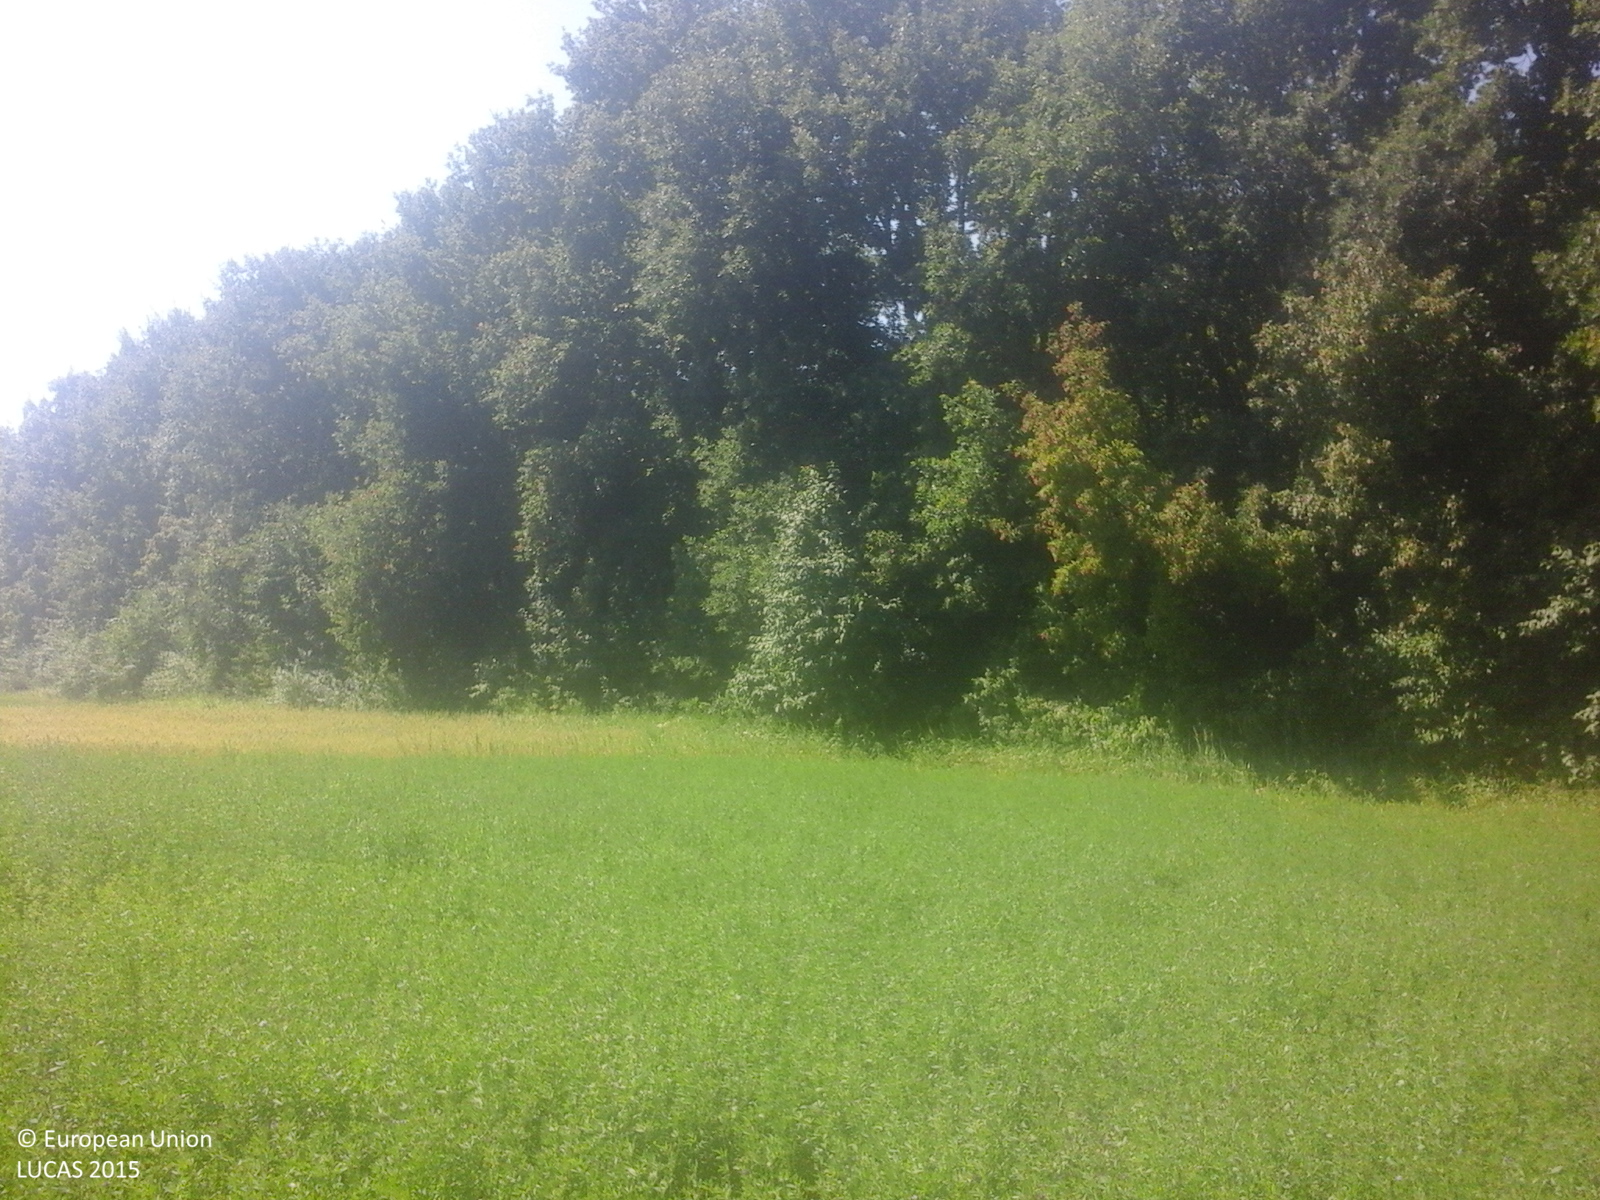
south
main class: Cropland
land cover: Lucerne
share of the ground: > 75 %
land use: Agriculture (excluding fallow land and kitchen gardens)
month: June
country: RO
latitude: 47.8282
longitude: 27.1140
